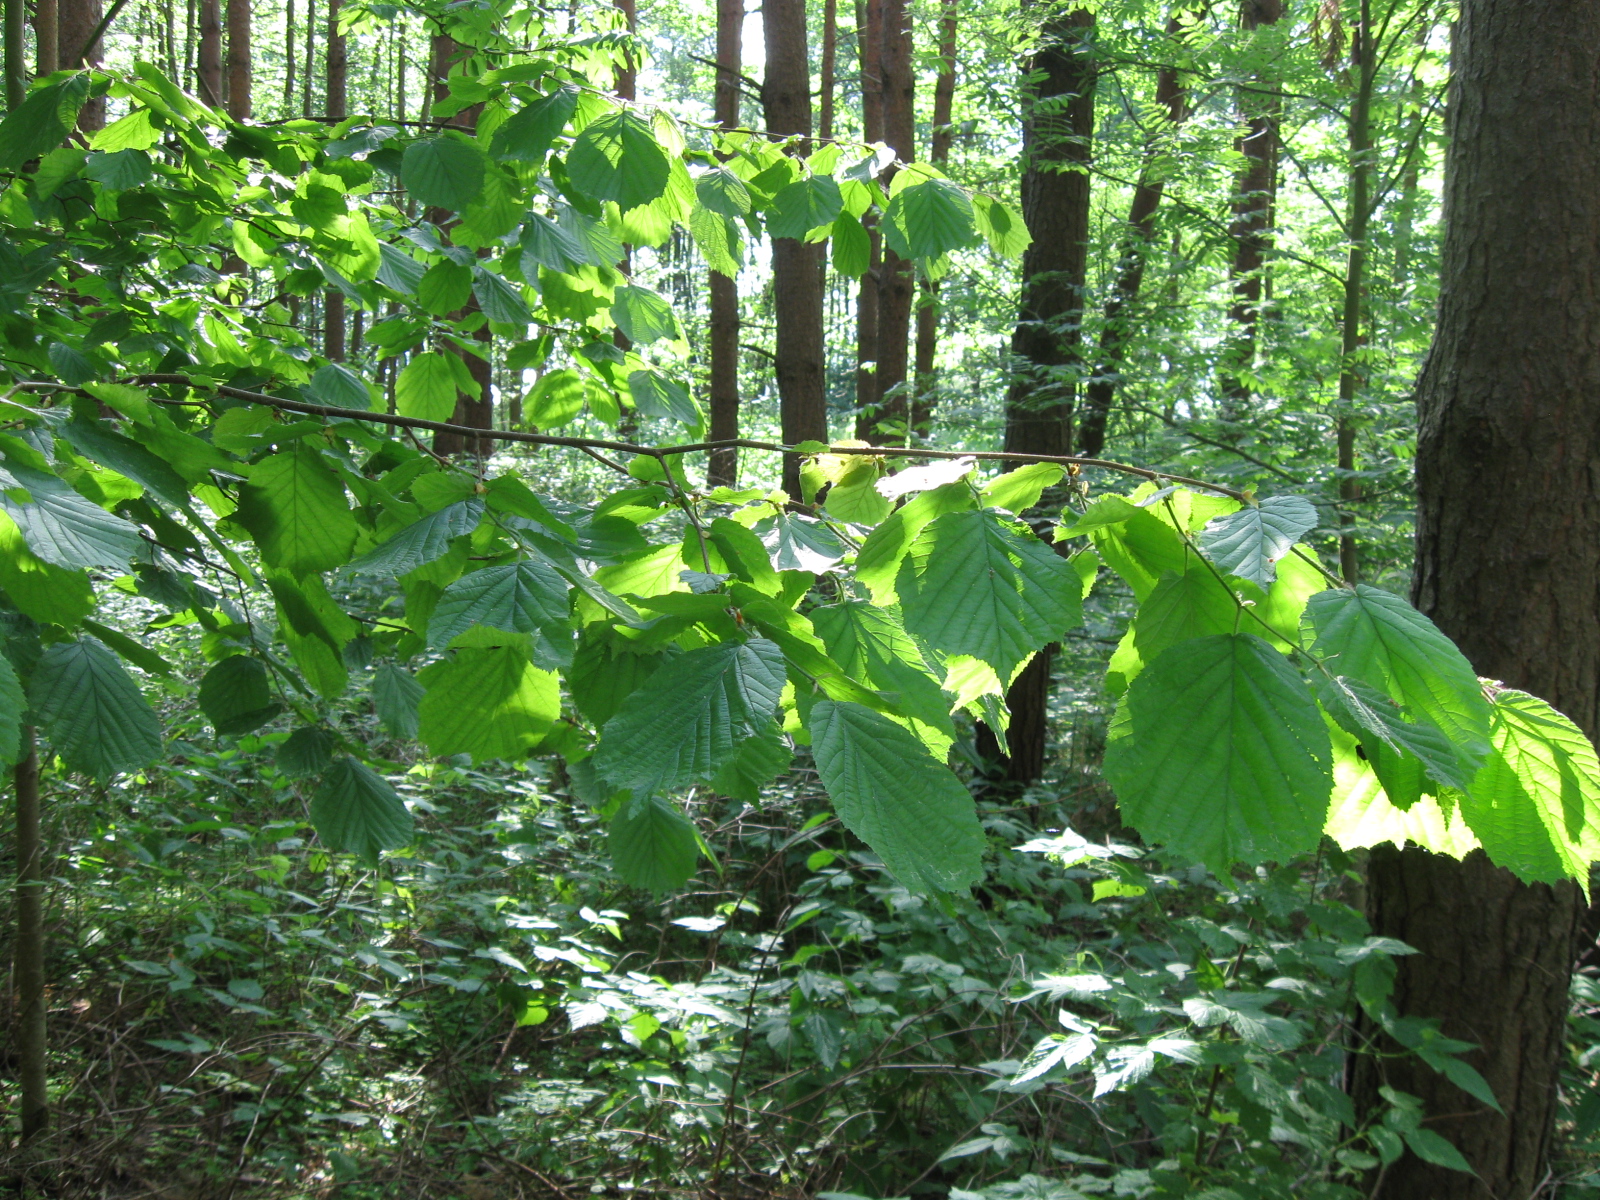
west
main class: Woodland
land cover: Pine dominated coniferous woodland
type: hemiboreal forest and nemoral coniferous forest and mixed broadleaved-coniferous forest
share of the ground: > 75 %
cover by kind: coniferous forest trees 90 %, broadleaved forest trees 5 %, herbaceous plants 5 %
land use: Forestry
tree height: > 5 m
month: June
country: LT
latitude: 54.2750
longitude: 23.7396
